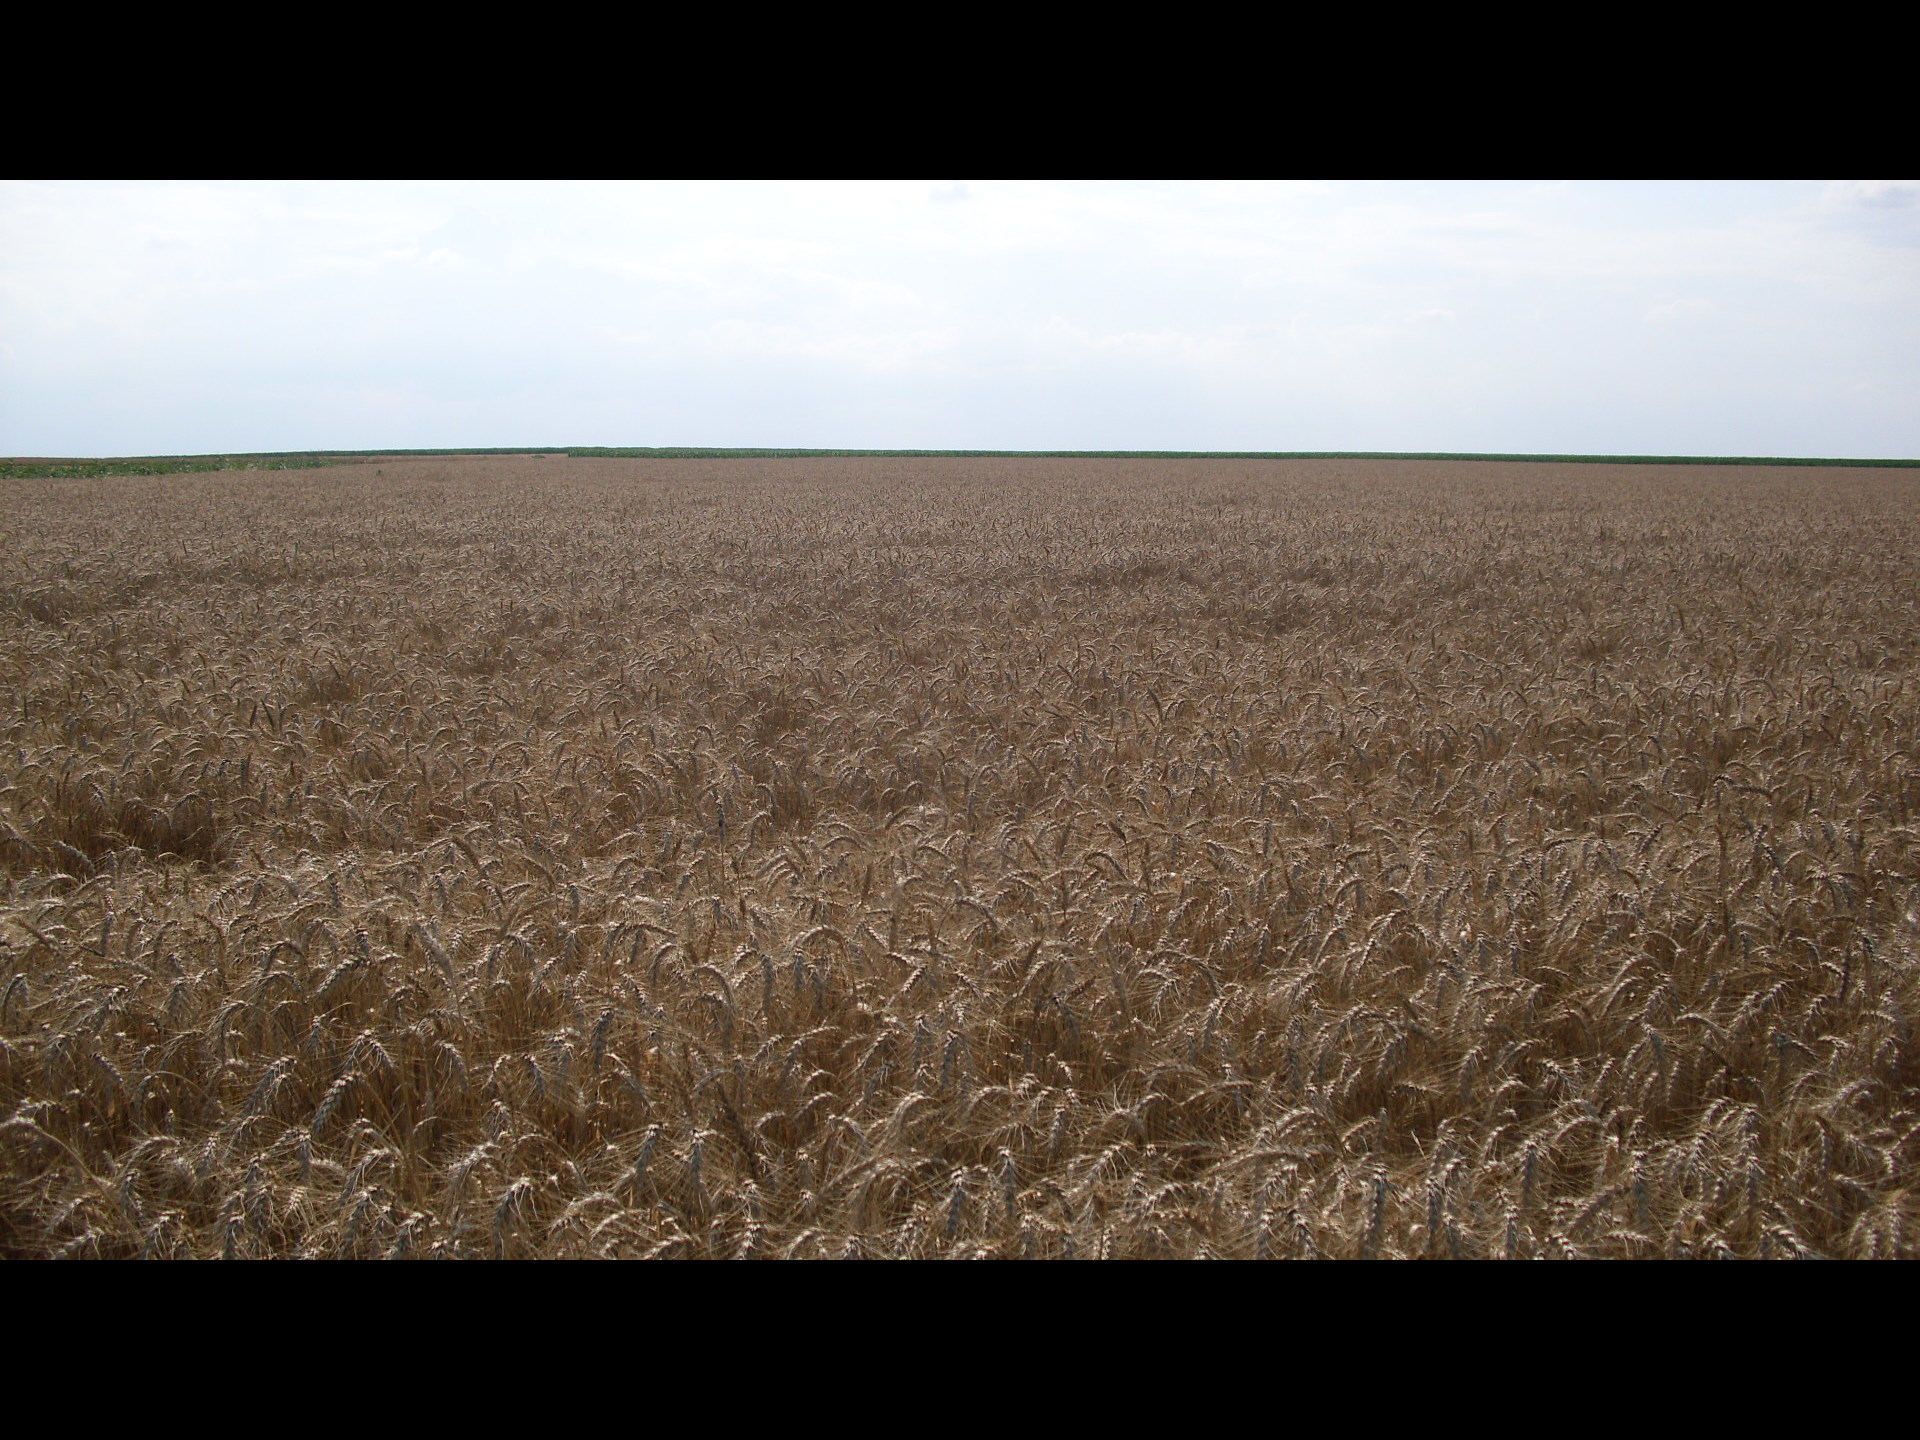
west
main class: Cropland
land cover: Common wheat
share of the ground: > 75 %
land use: Agriculture (excluding fallow land and kitchen gardens)
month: June
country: BG
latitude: 43.6661
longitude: 23.3507
